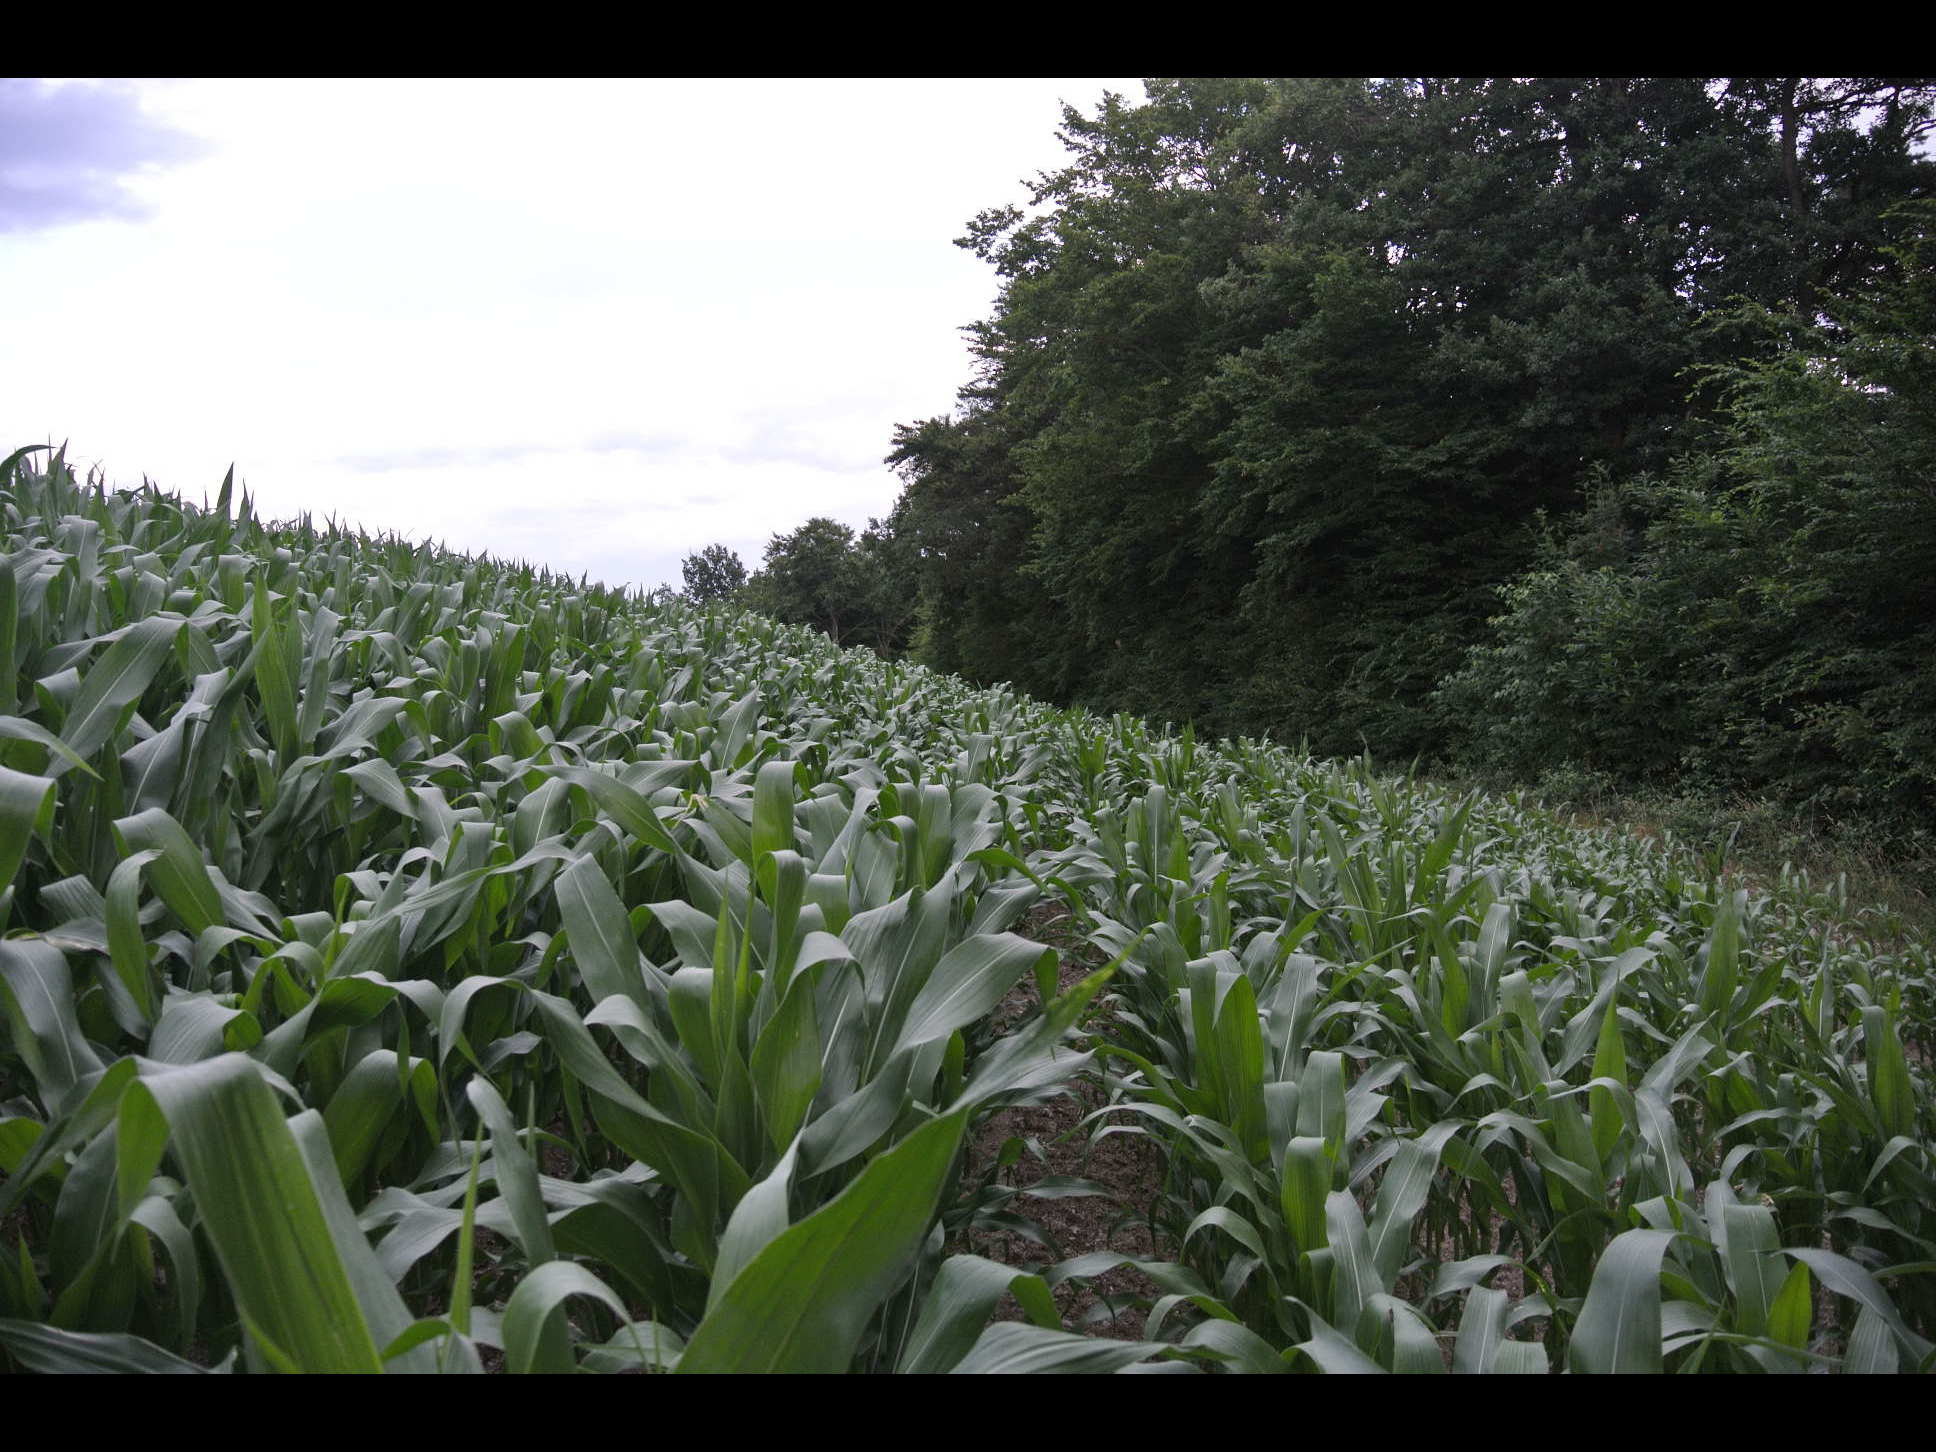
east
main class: Cropland
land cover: Maize
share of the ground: > 75 %
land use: Agriculture (excluding fallow land and kitchen gardens)
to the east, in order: Maize
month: July
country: AT
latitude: 47.6702
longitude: 16.1962
